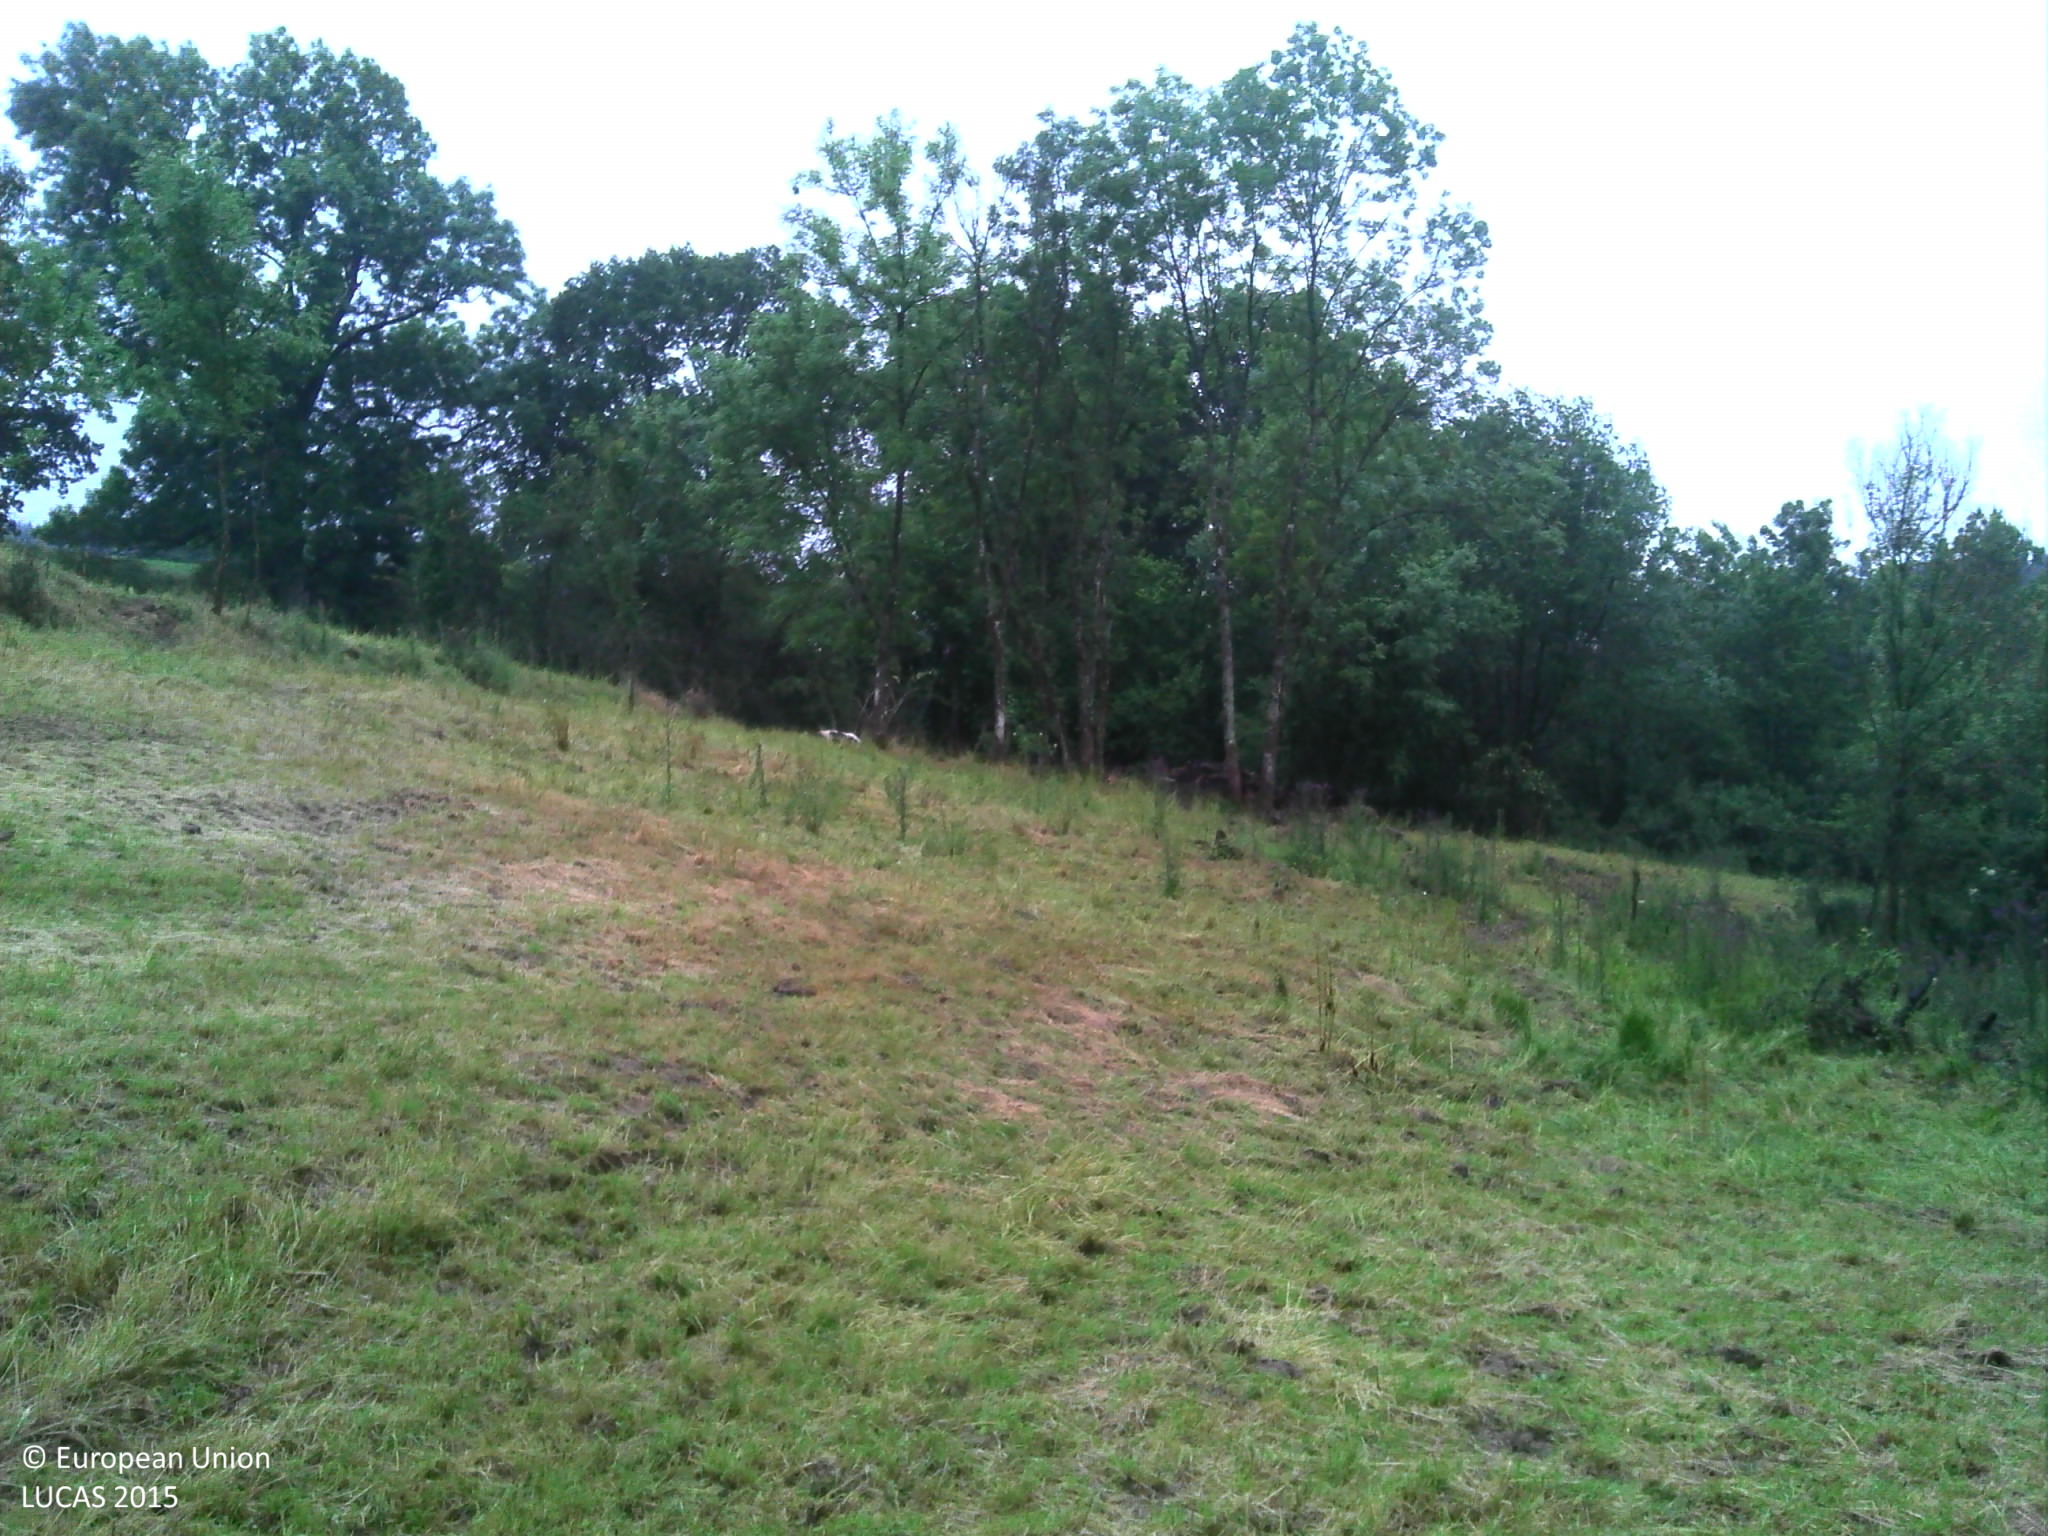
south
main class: Grassland
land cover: Grassland without tree/shrub cover
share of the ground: > 75 %
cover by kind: herbaceous plants 100 %
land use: Agriculture (excluding fallow land and kitchen gardens)
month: June
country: BE
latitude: 50.2753
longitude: 5.4941
